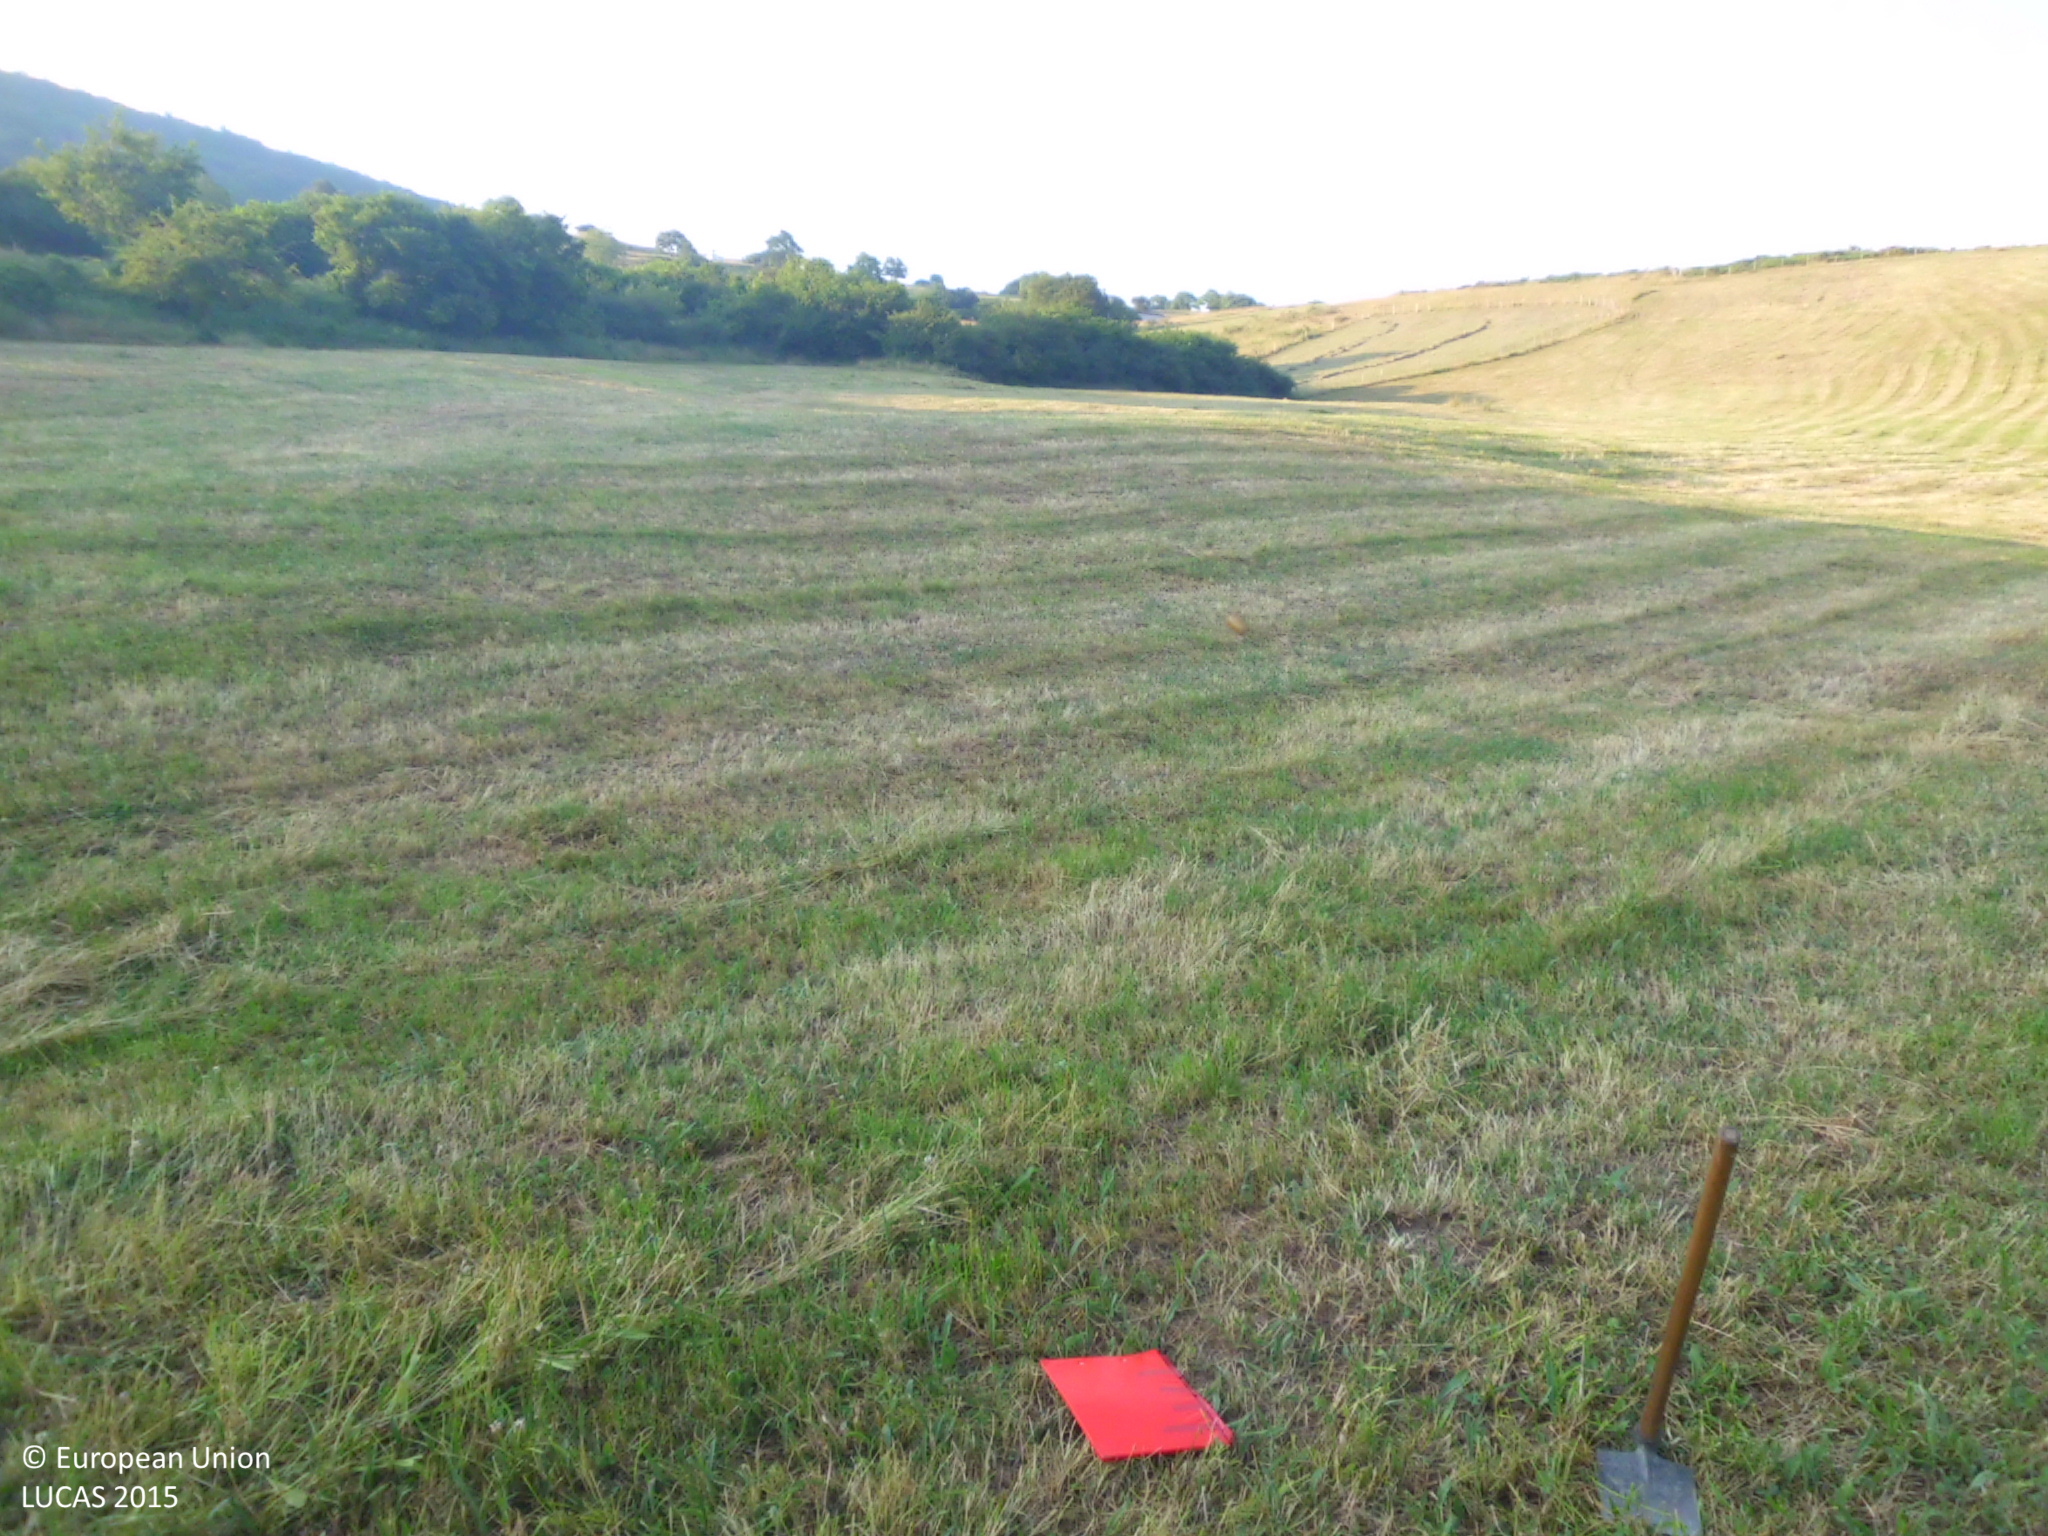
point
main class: Grassland
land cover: Grassland without tree/shrub cover
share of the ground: > 75 %
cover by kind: herbaceous plants 95 %, shrubs 5 %
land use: Agriculture (excluding fallow land and kitchen gardens)
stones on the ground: < 10 %
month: June
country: ES
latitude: 43.1294
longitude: -4.0762
